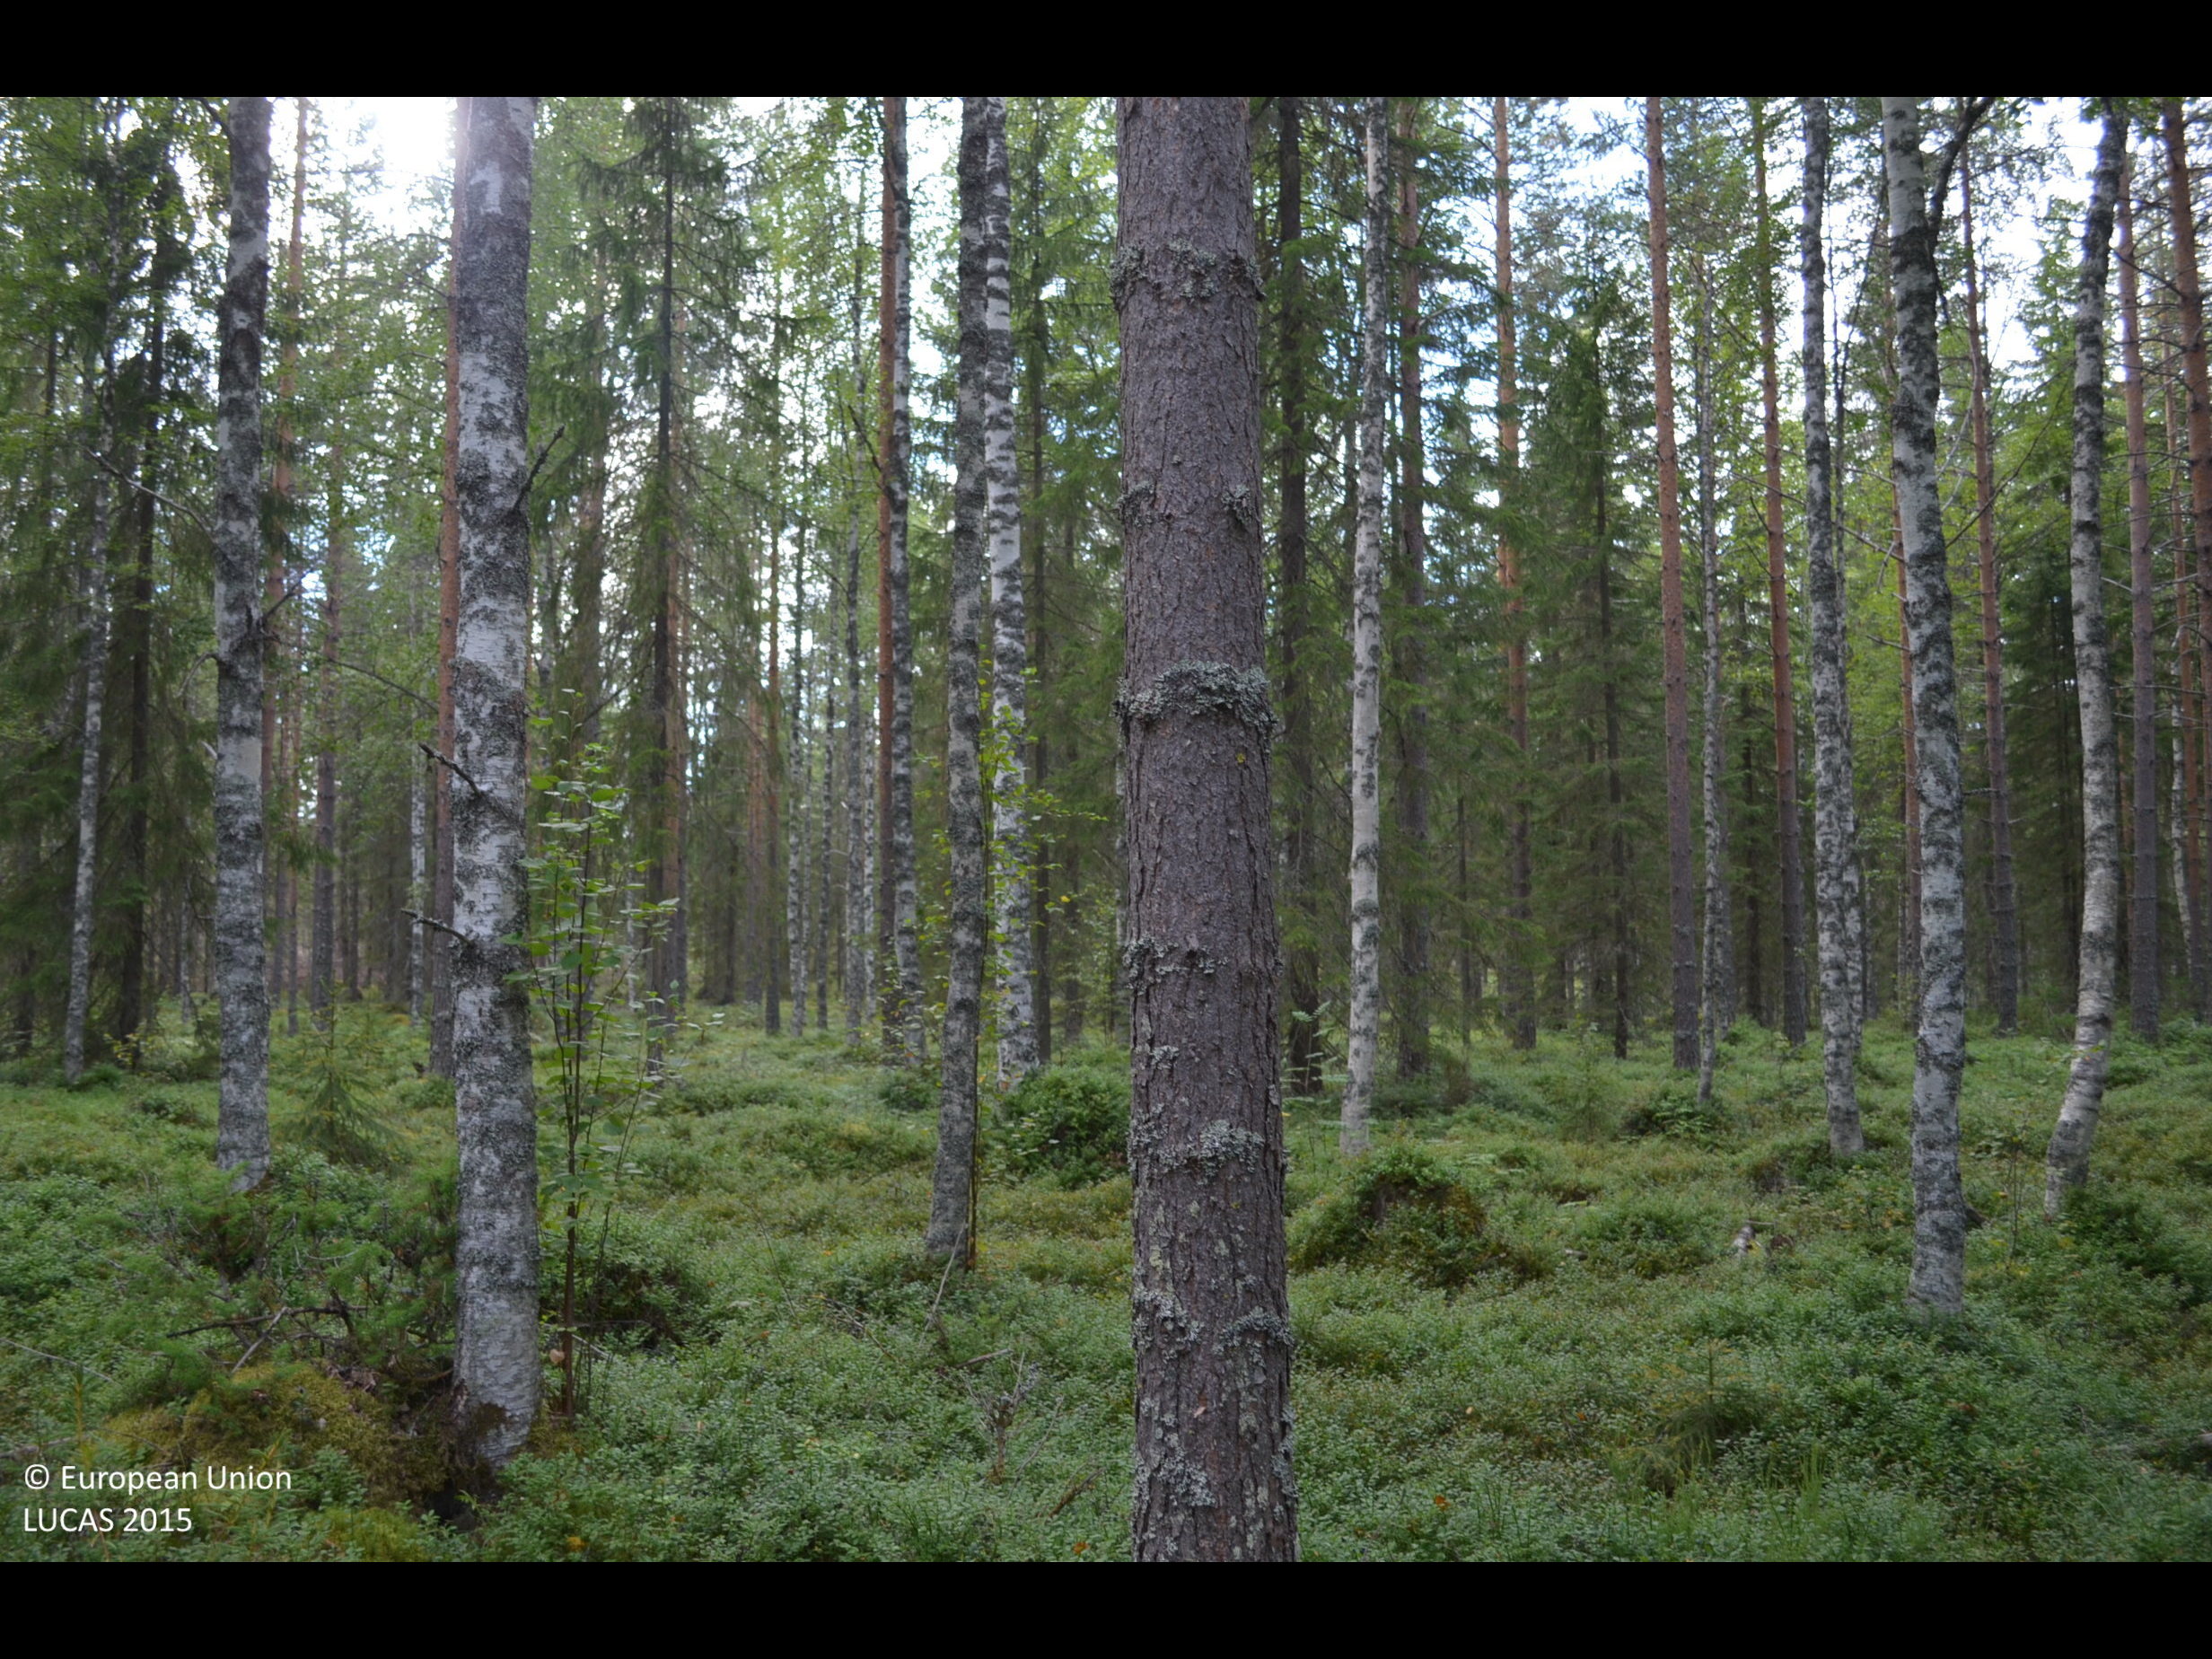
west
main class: Woodland
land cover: Pine dominated mixed woodland
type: boreal forest
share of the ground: 50 - 75 %
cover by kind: coniferous forest trees 35 %, broadleaved forest trees 35 %, shrubs 25 %, lichens and mosses 5 %
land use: Forestry
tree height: > 5 m
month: August
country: FI
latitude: 62.1946
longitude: 24.1716
